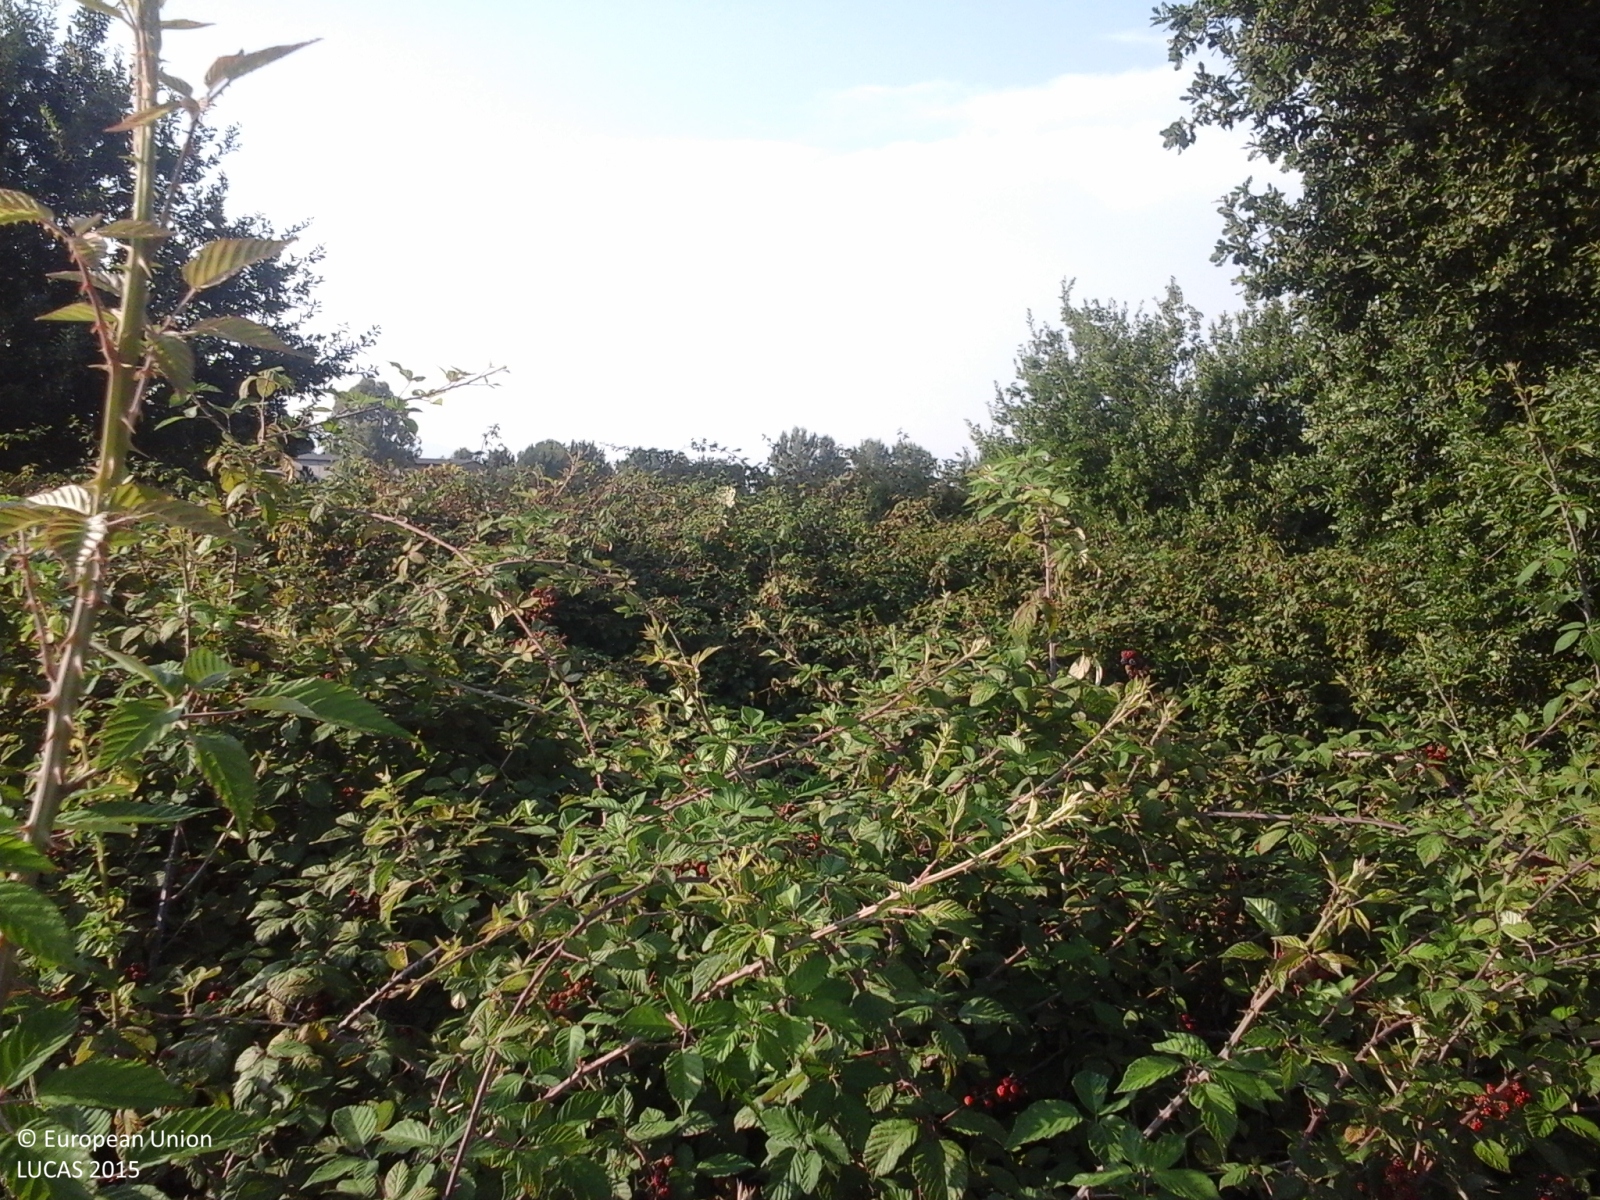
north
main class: Cropland
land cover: Maize
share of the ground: > 75 %
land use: Agriculture (excluding fallow land and kitchen gardens)
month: July
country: IT
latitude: 41.5304
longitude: 12.8054
